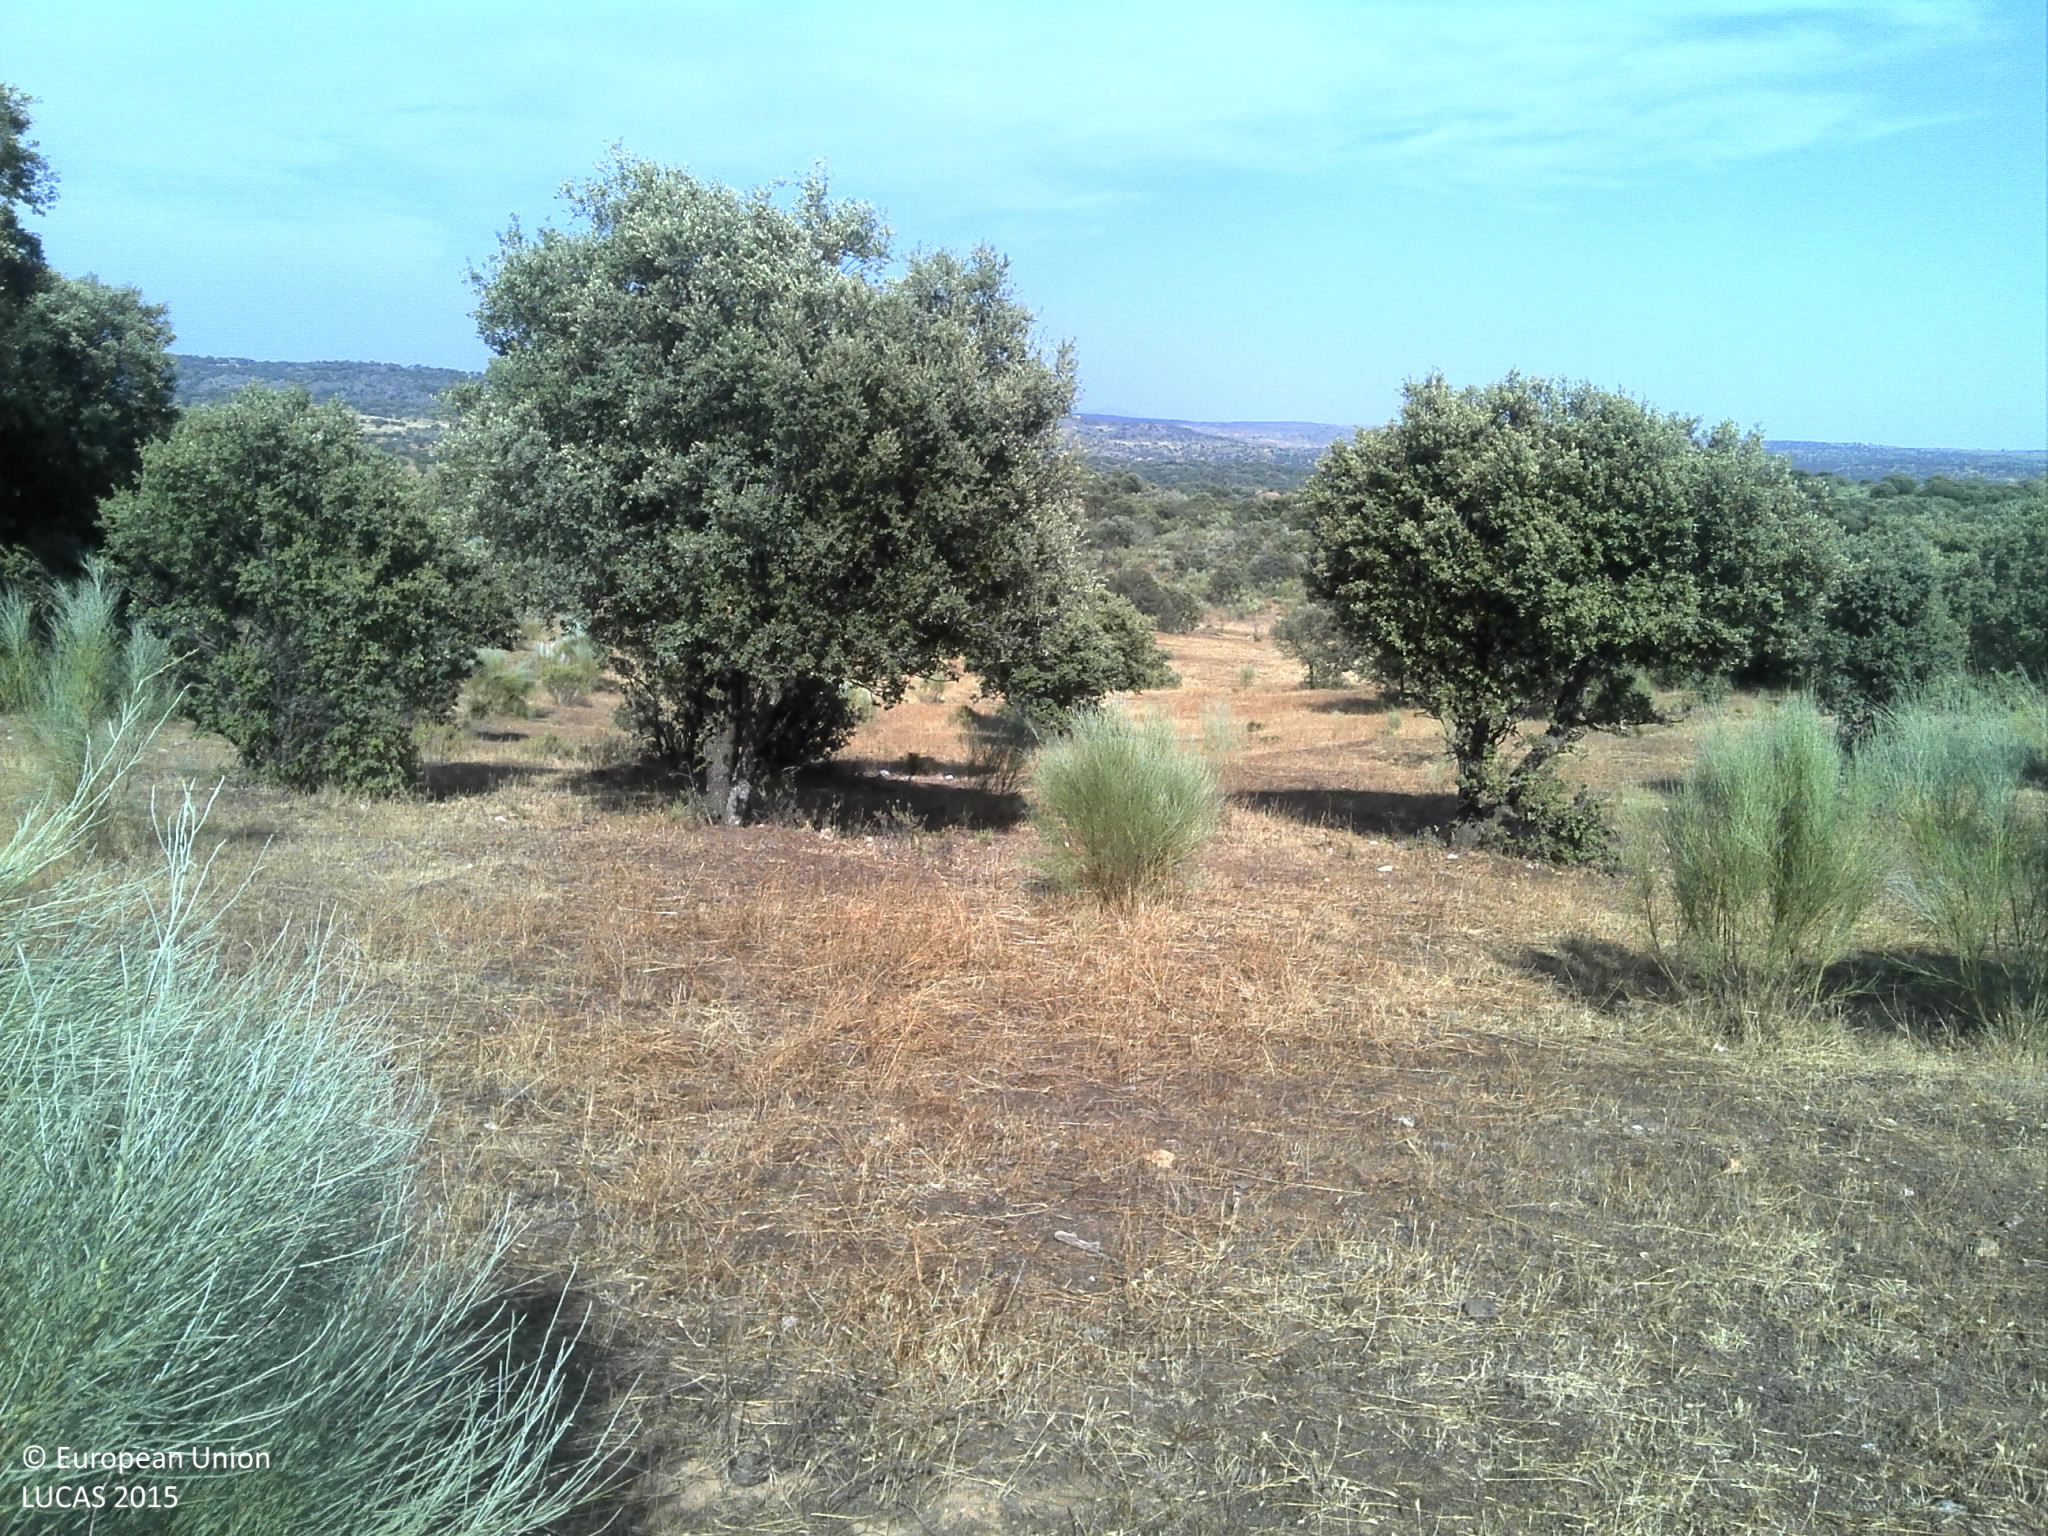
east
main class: Woodland
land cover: Broadleaved woodland
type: broadleaved evergreen forest
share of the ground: 10 - 25 %
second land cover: Grassland without tree/shrub cover
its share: 25 - 50 %
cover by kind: unconsolidated bare surface 45 %, herbaceous plants 30 %, broadleaved forest trees 15 %, shrubs 10 %
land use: Forestry
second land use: Agriculture (excluding fallow land and kitchen gardens)
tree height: > 5 m
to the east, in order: Broadleaved woodland; Grassland without tree/shrub cover; Broadleaved woodland; Grassland without tree/shrub cover; Broadleaved woodland; Fences; Grassland without tree/shrub cover
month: June
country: PT
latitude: 39.8670
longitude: -6.9568
